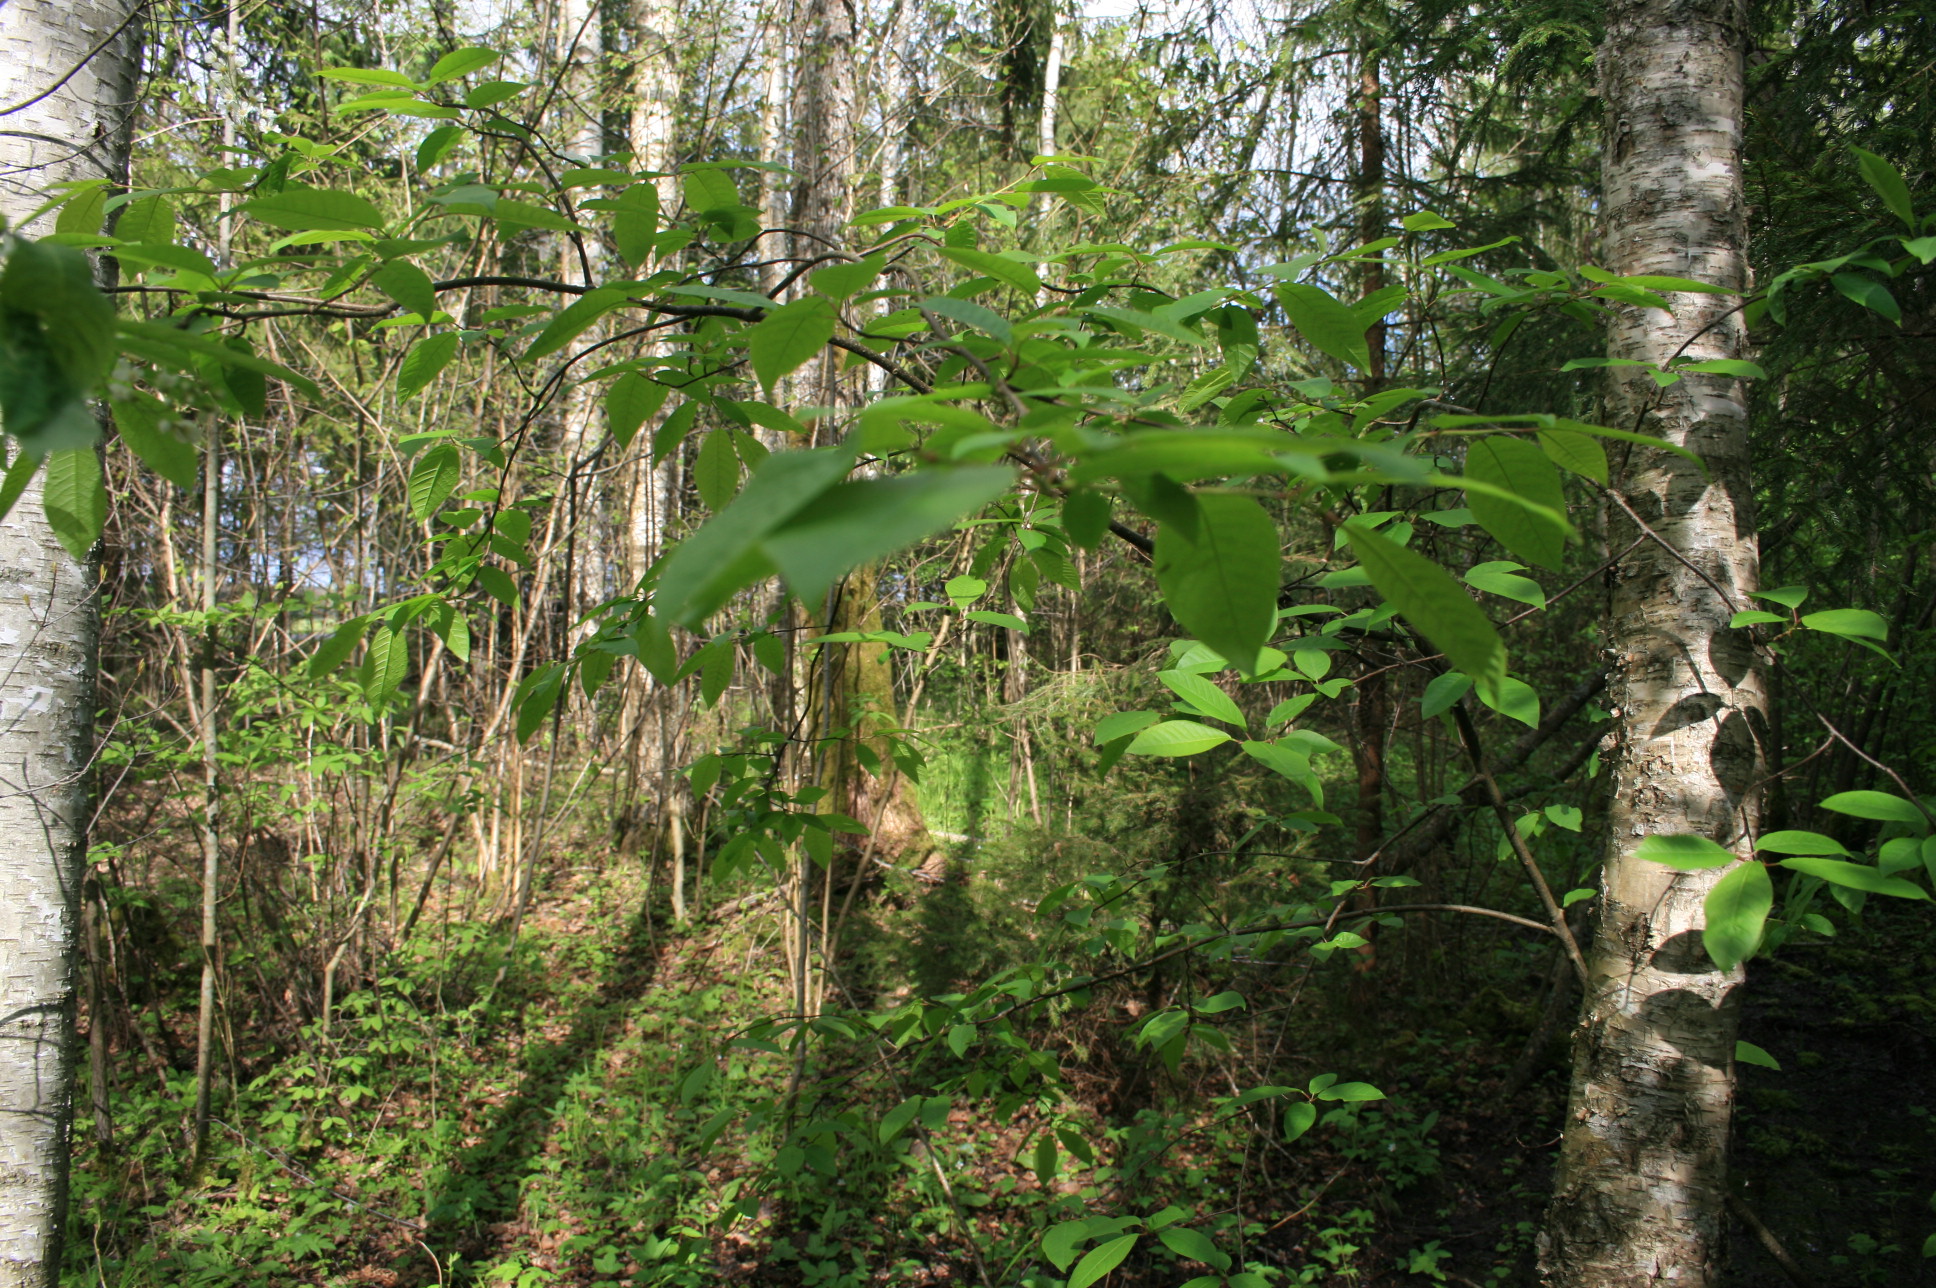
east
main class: Woodland
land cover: Other mixed woodland
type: hemiboreal forest and nemoral coniferous forest and mixed broadleaved-coniferous forest
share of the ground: > 75 %
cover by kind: broadleaved forest trees 60 %, coniferous forest trees 35 %, herbaceous plants 5 %
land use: Forestry
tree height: > 5 m
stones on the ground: < 10 %
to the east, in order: Other mixed woodland; Spontaneously vegetated surfaces; Grass margins; Paved roads, cycling and walking lanes; Grass margins; Spontaneously vegetated surfaces
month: May
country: LT
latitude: 56.2250
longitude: 21.3801
